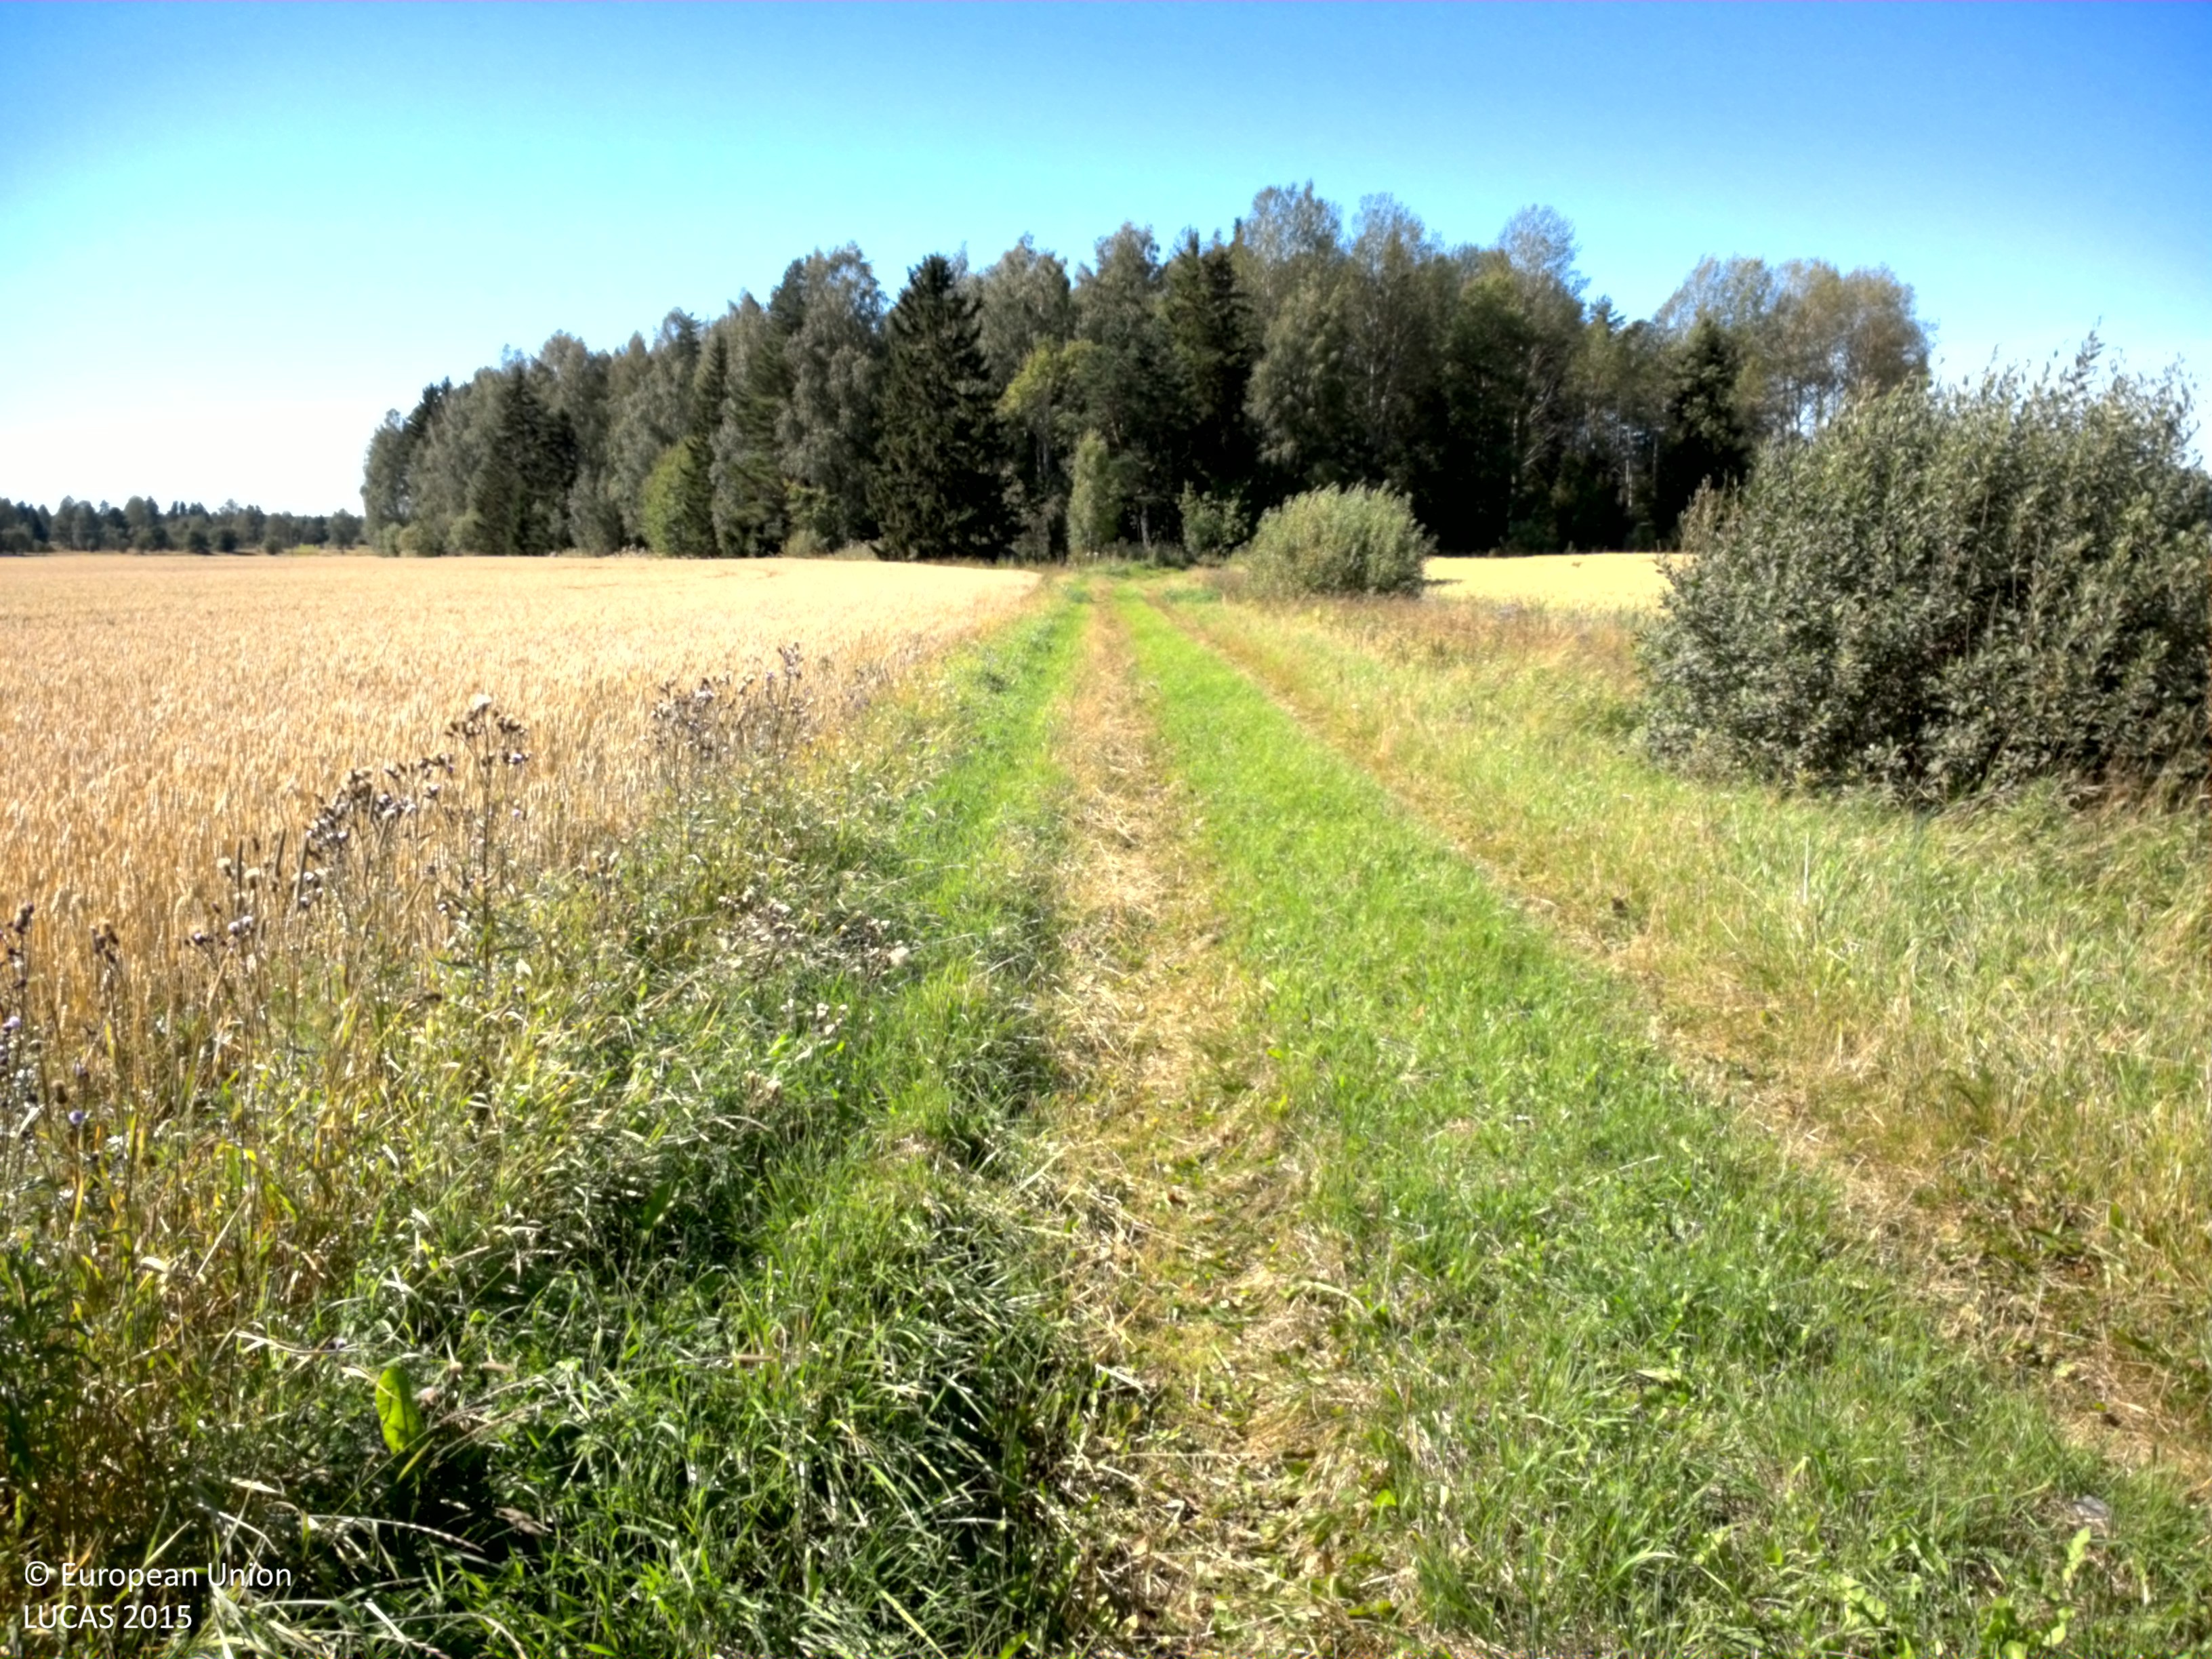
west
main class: Cropland
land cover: Common wheat
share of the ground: > 75 %
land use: Agriculture (excluding fallow land and kitchen gardens)
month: August
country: SE
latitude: 60.1301
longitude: 17.0657
